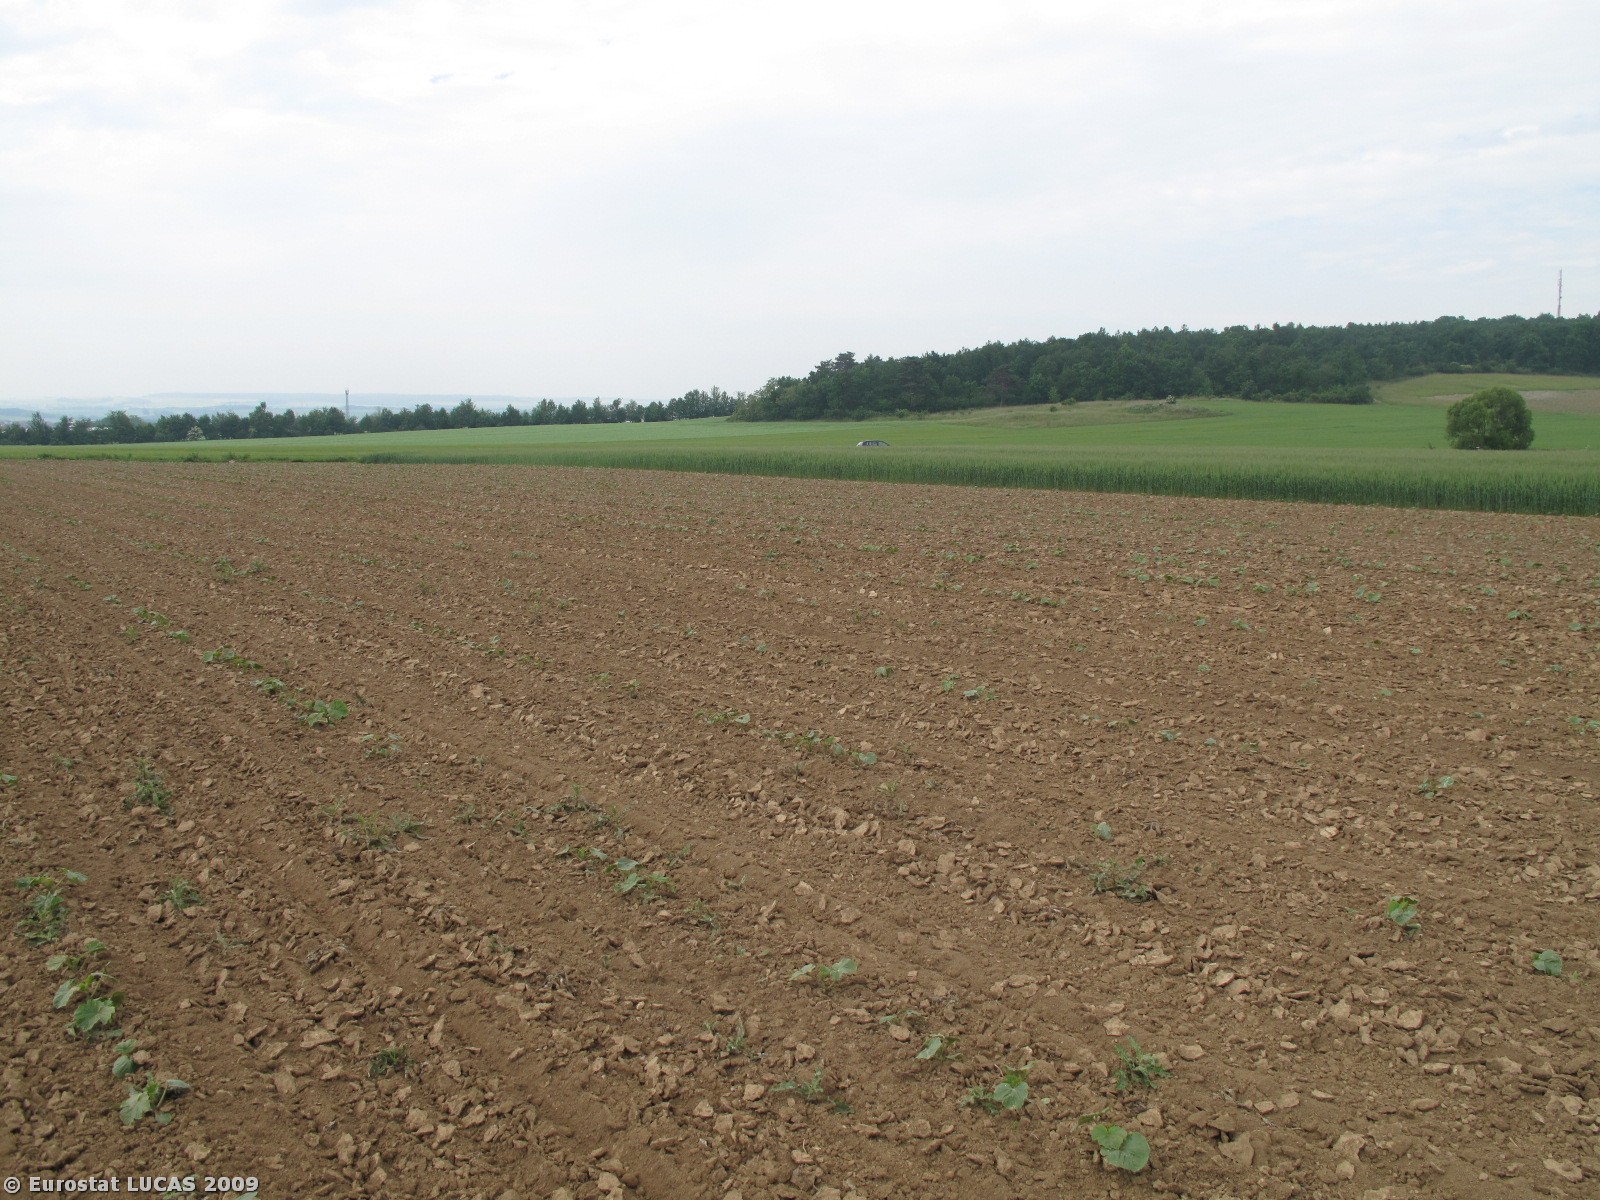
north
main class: Cropland
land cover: Other fibre and oleaginous crops
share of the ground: < 10 %
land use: Agriculture (excluding fallow land and kitchen gardens)
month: June
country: AT
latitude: 48.6288
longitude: 15.8246
